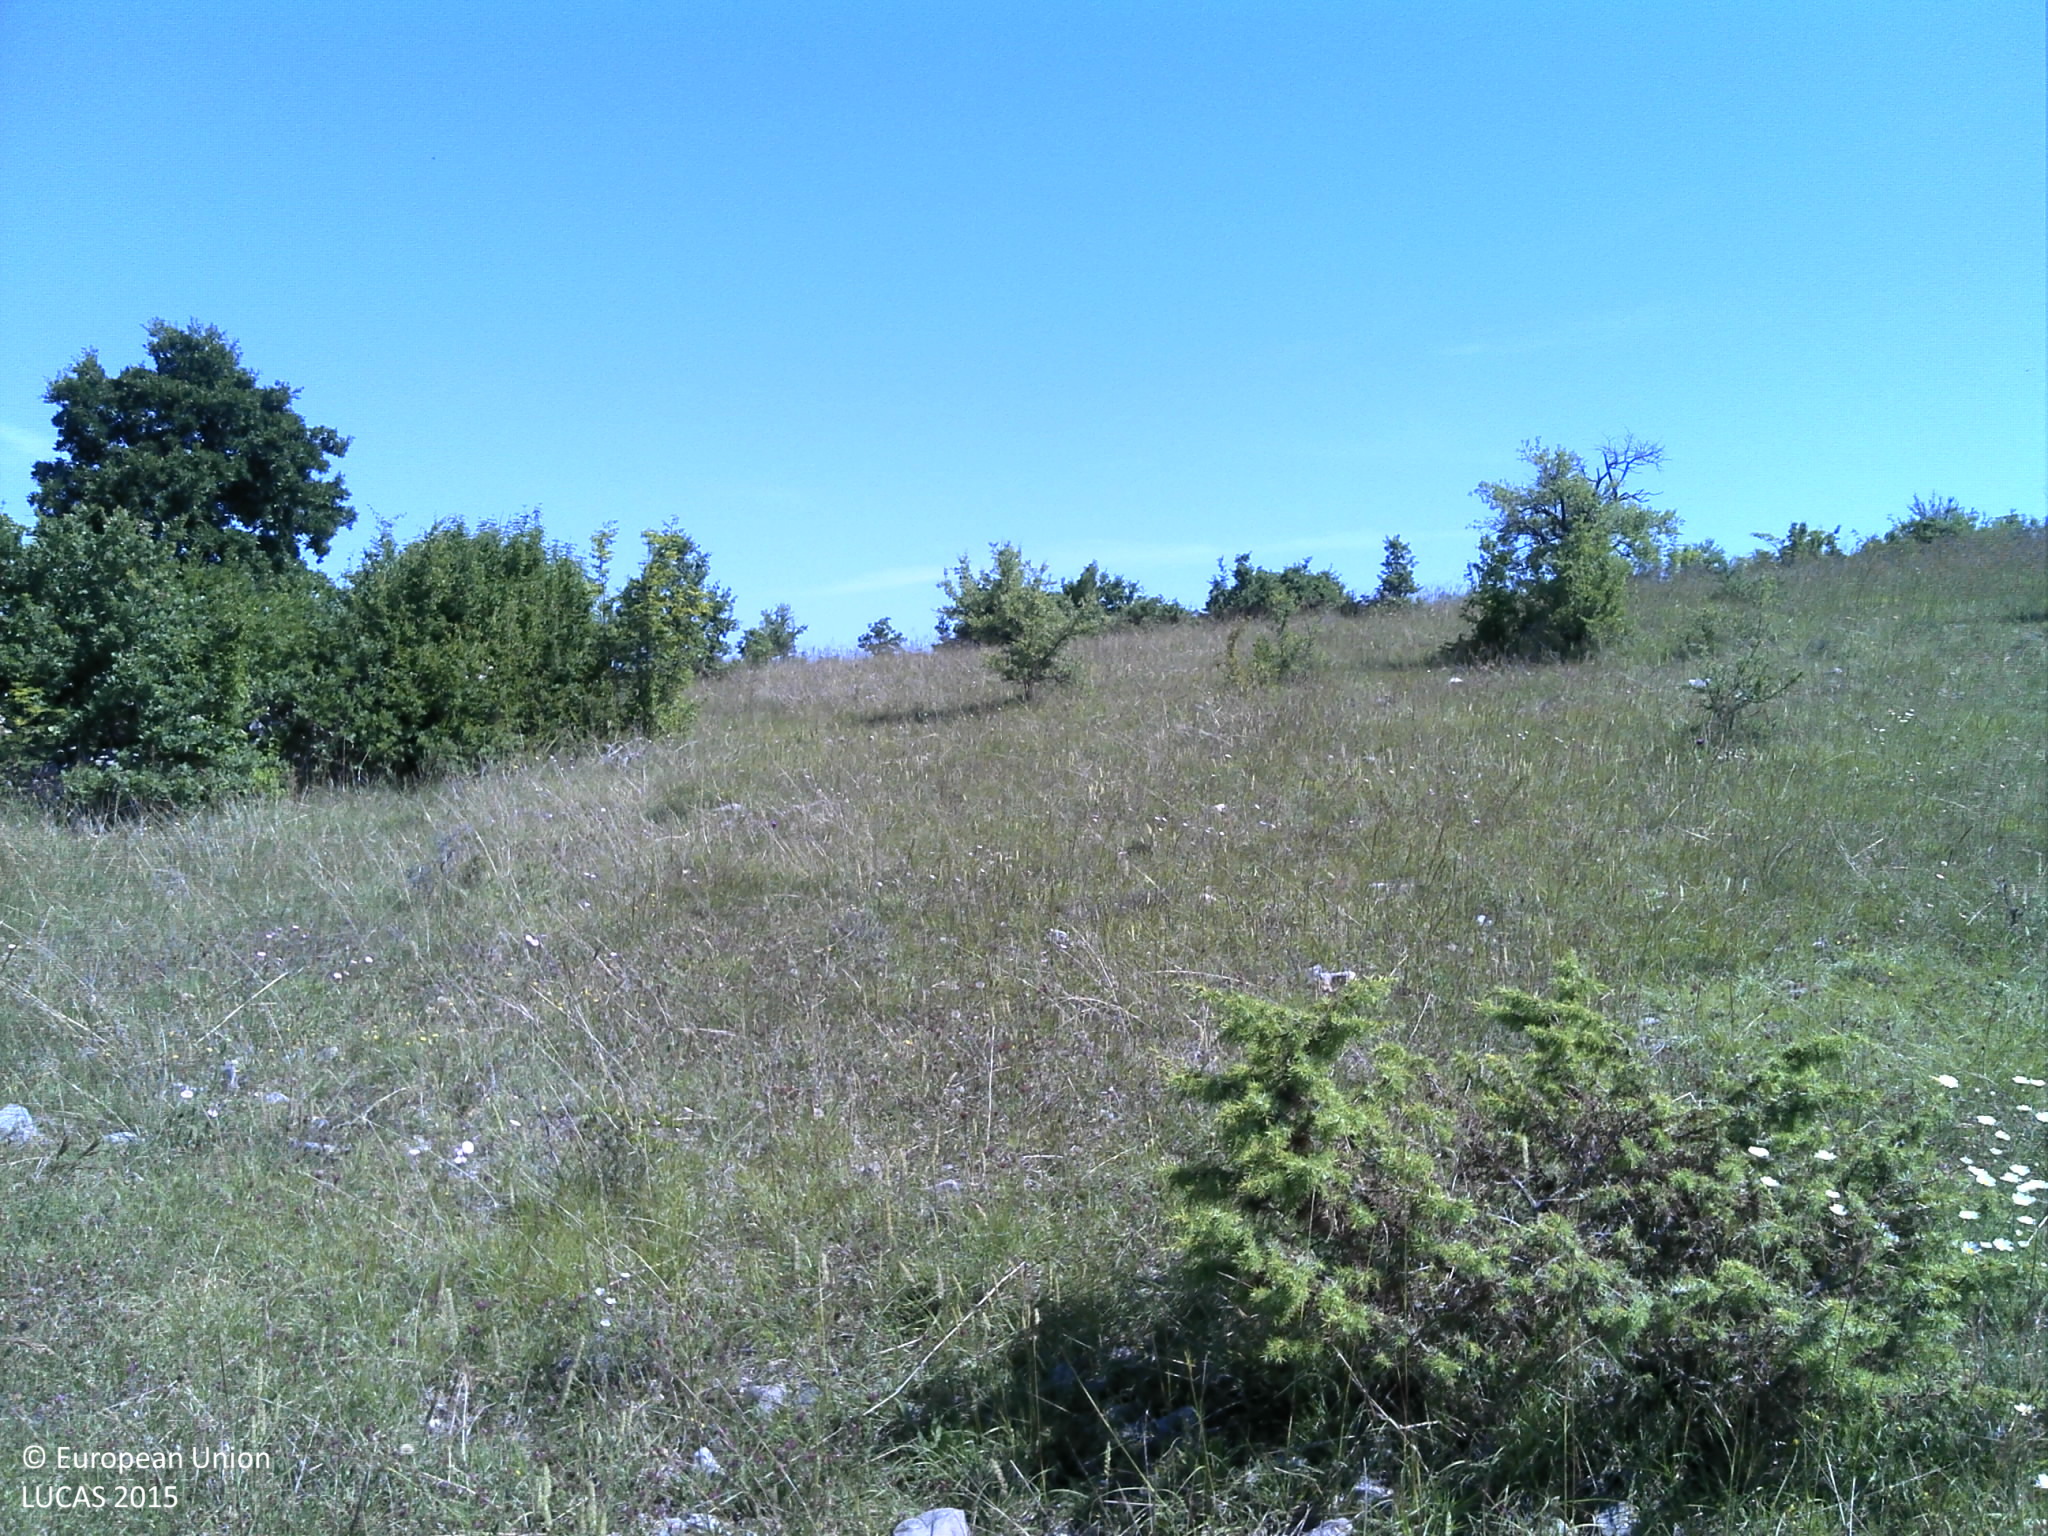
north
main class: Grassland
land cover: Grassland with sparse tree/shrub cover
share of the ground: > 75 %
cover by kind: herbaceous plants 80 %, shrubs 10 %, broadleaved forest trees 5 %, unconsolidated bare surface 5 %
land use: Abandoned areas
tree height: < 5 m
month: June
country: HR
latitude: 43.7498
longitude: 16.1884
